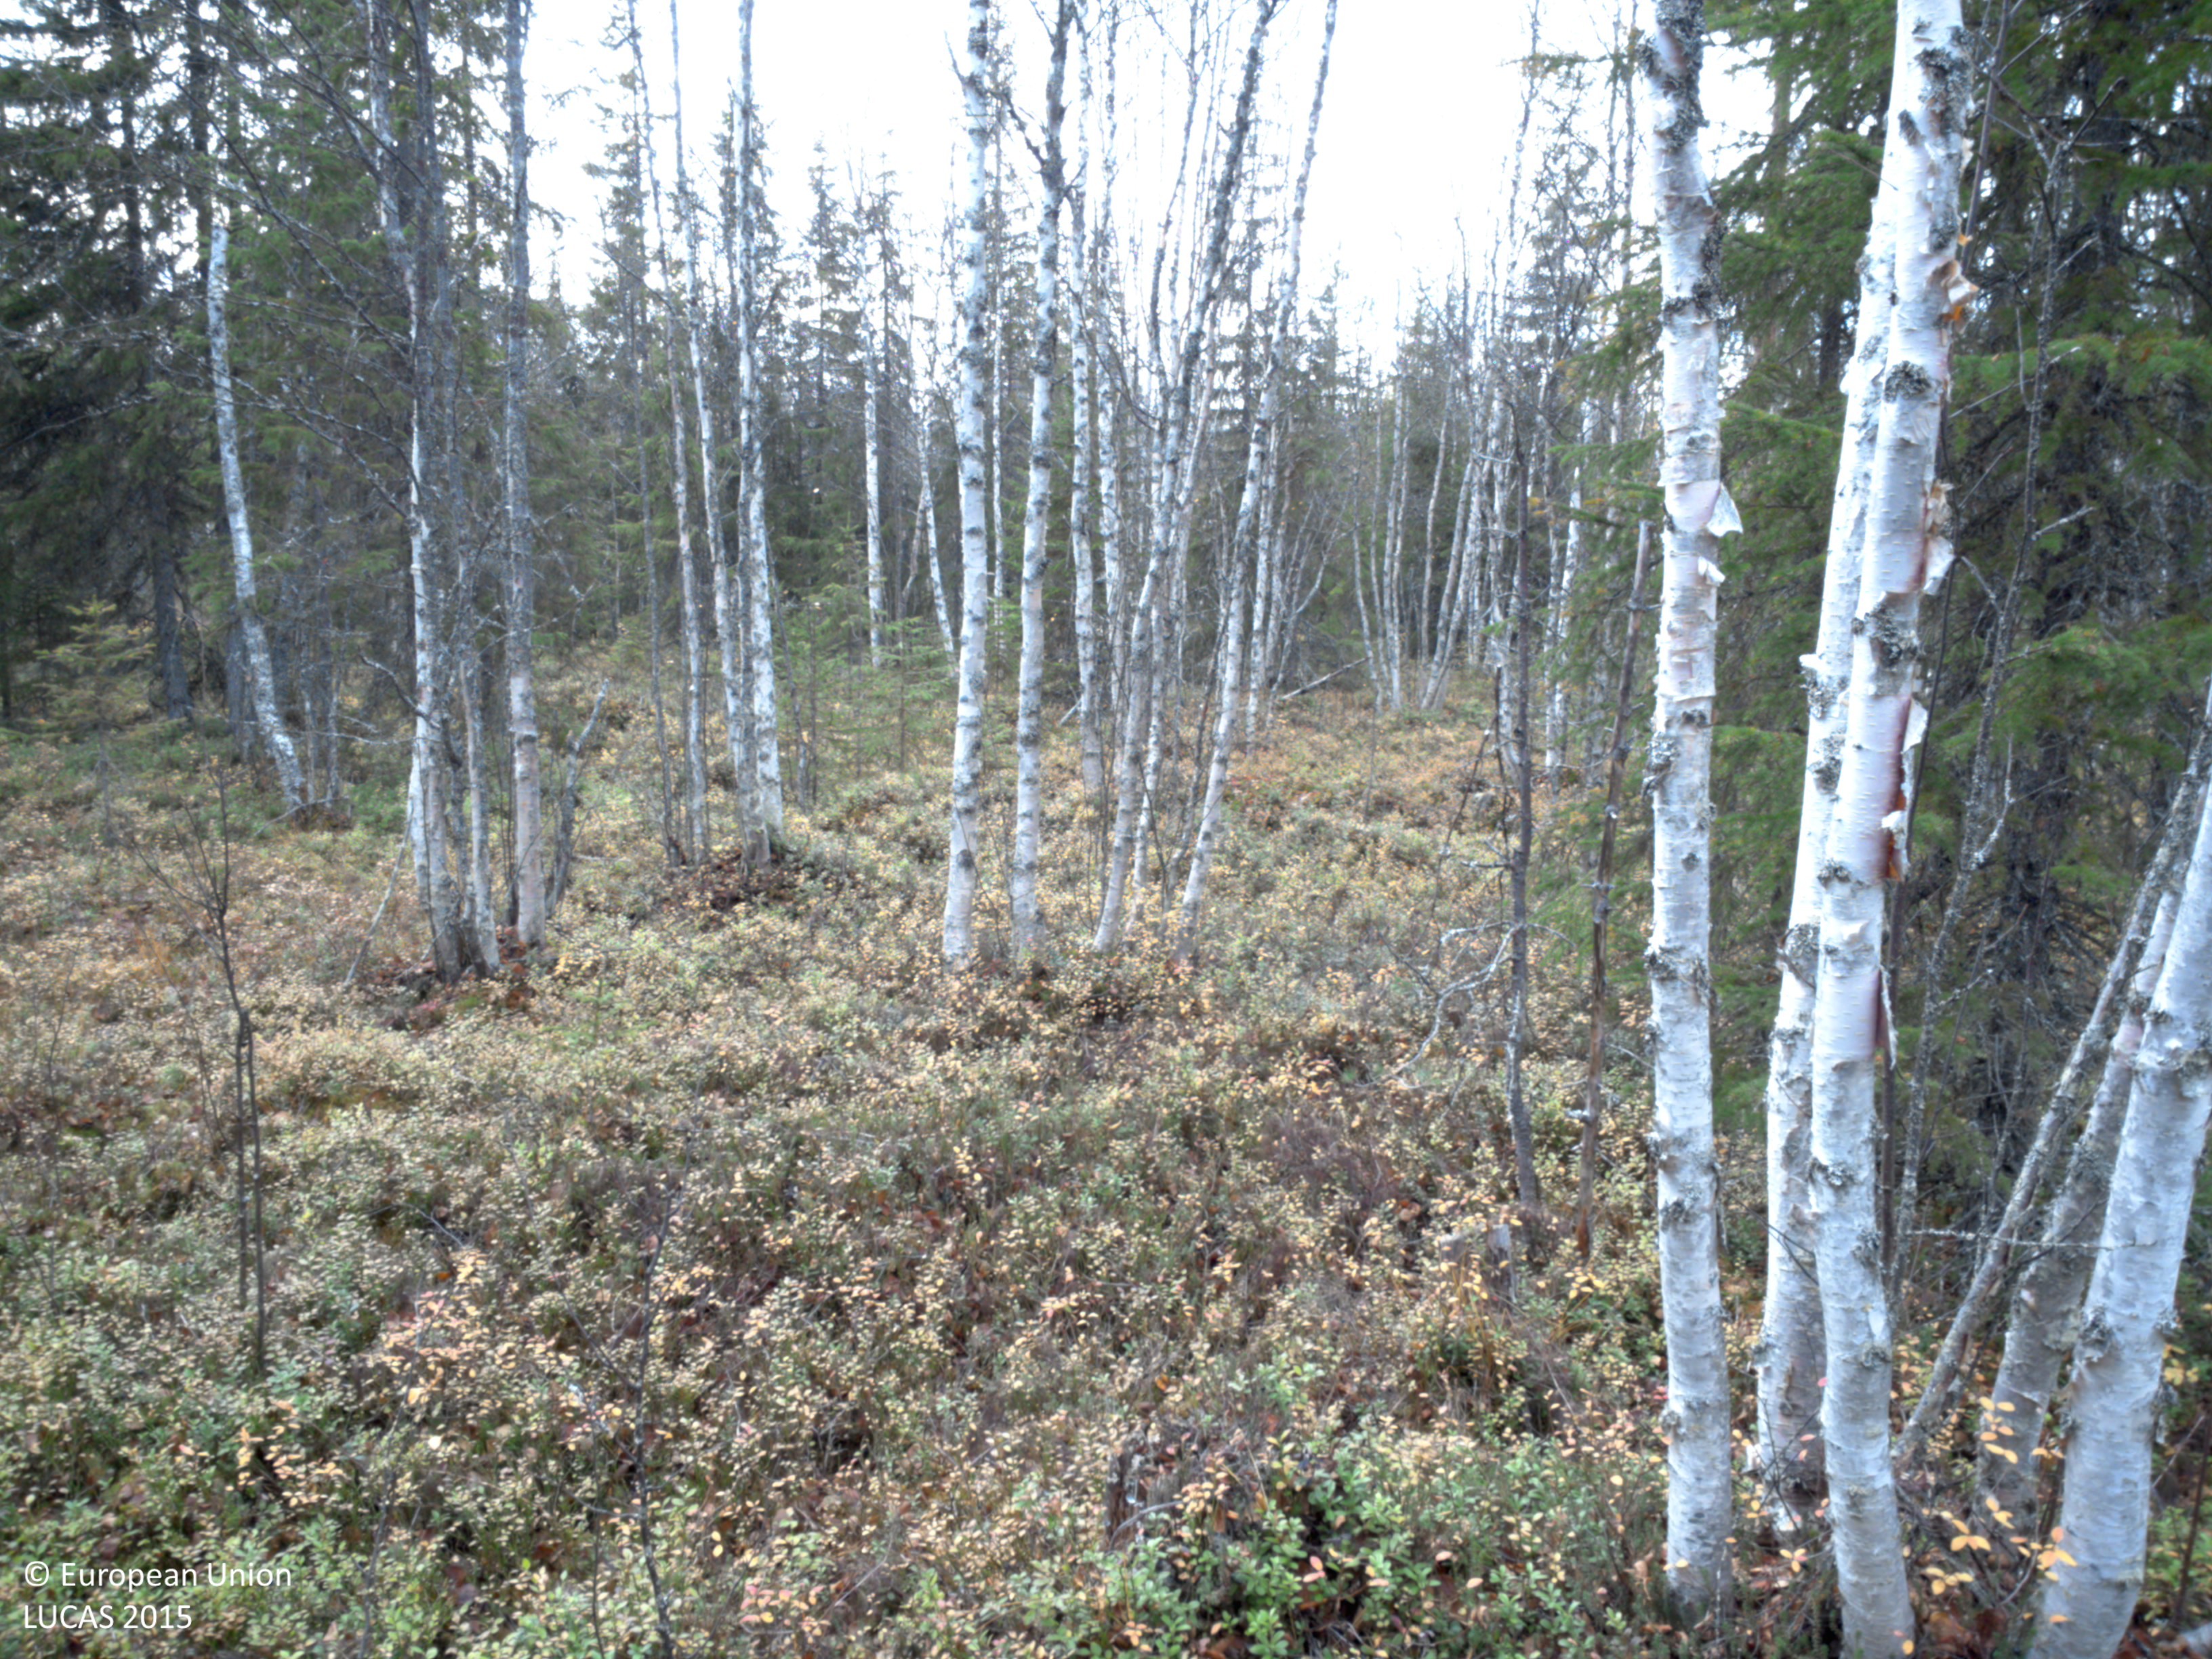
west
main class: Woodland
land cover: Spruce dominated mixed woodland
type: boreal forest
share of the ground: 50 - 75 %
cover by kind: coniferous forest trees 30 %, broadleaved forest trees 30 %, shrubs 30 %, lichens and mosses 10 %
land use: Forestry
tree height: > 5 m
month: October
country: SE
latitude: 64.7924
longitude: 18.0671
